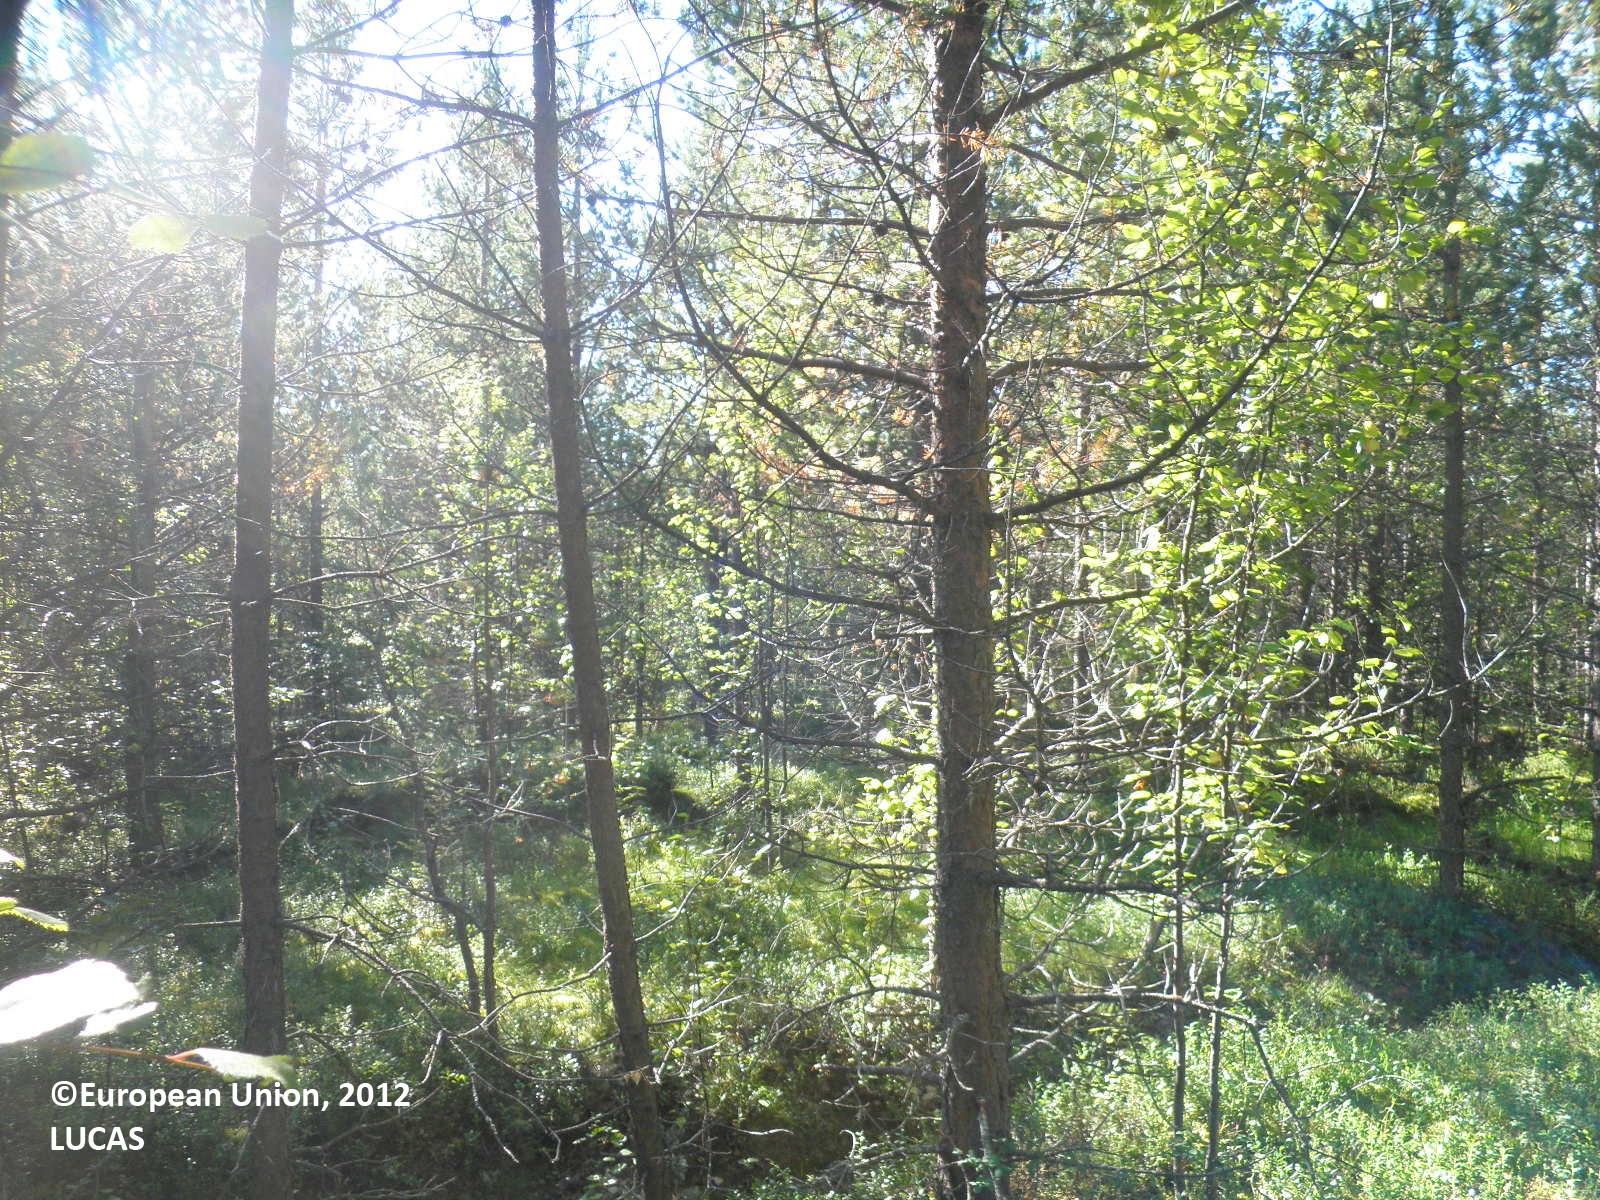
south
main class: Woodland
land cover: Pine dominated mixed woodland
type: boreal forest
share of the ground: 50 - 75 %
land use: Forestry
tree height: > 5 m
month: August
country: FI
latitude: 67.6556
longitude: 25.4372
